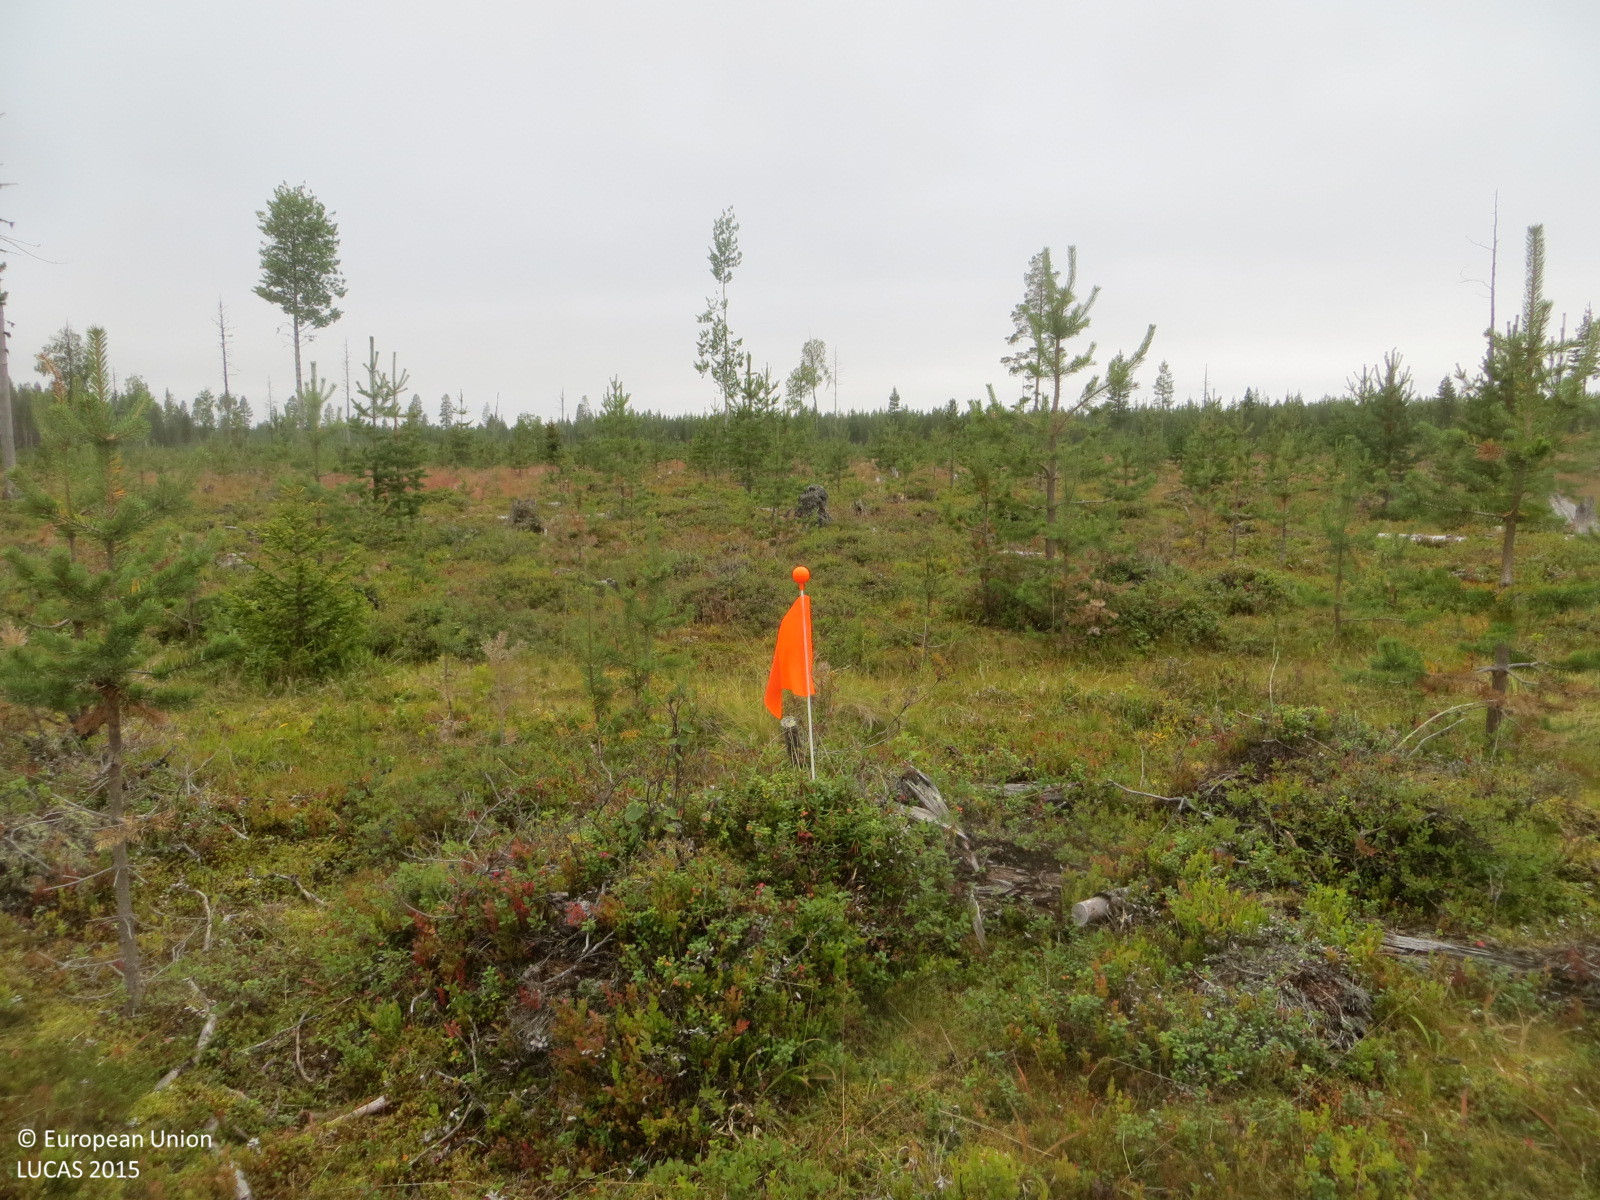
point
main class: Woodland
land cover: Pine dominated coniferous woodland
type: boreal forest
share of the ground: 10 - 25 %
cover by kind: shrubs 80 %, coniferous forest trees 20 %
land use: Forestry
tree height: < 5 m
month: August
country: FI
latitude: 67.3254
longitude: 24.7521
